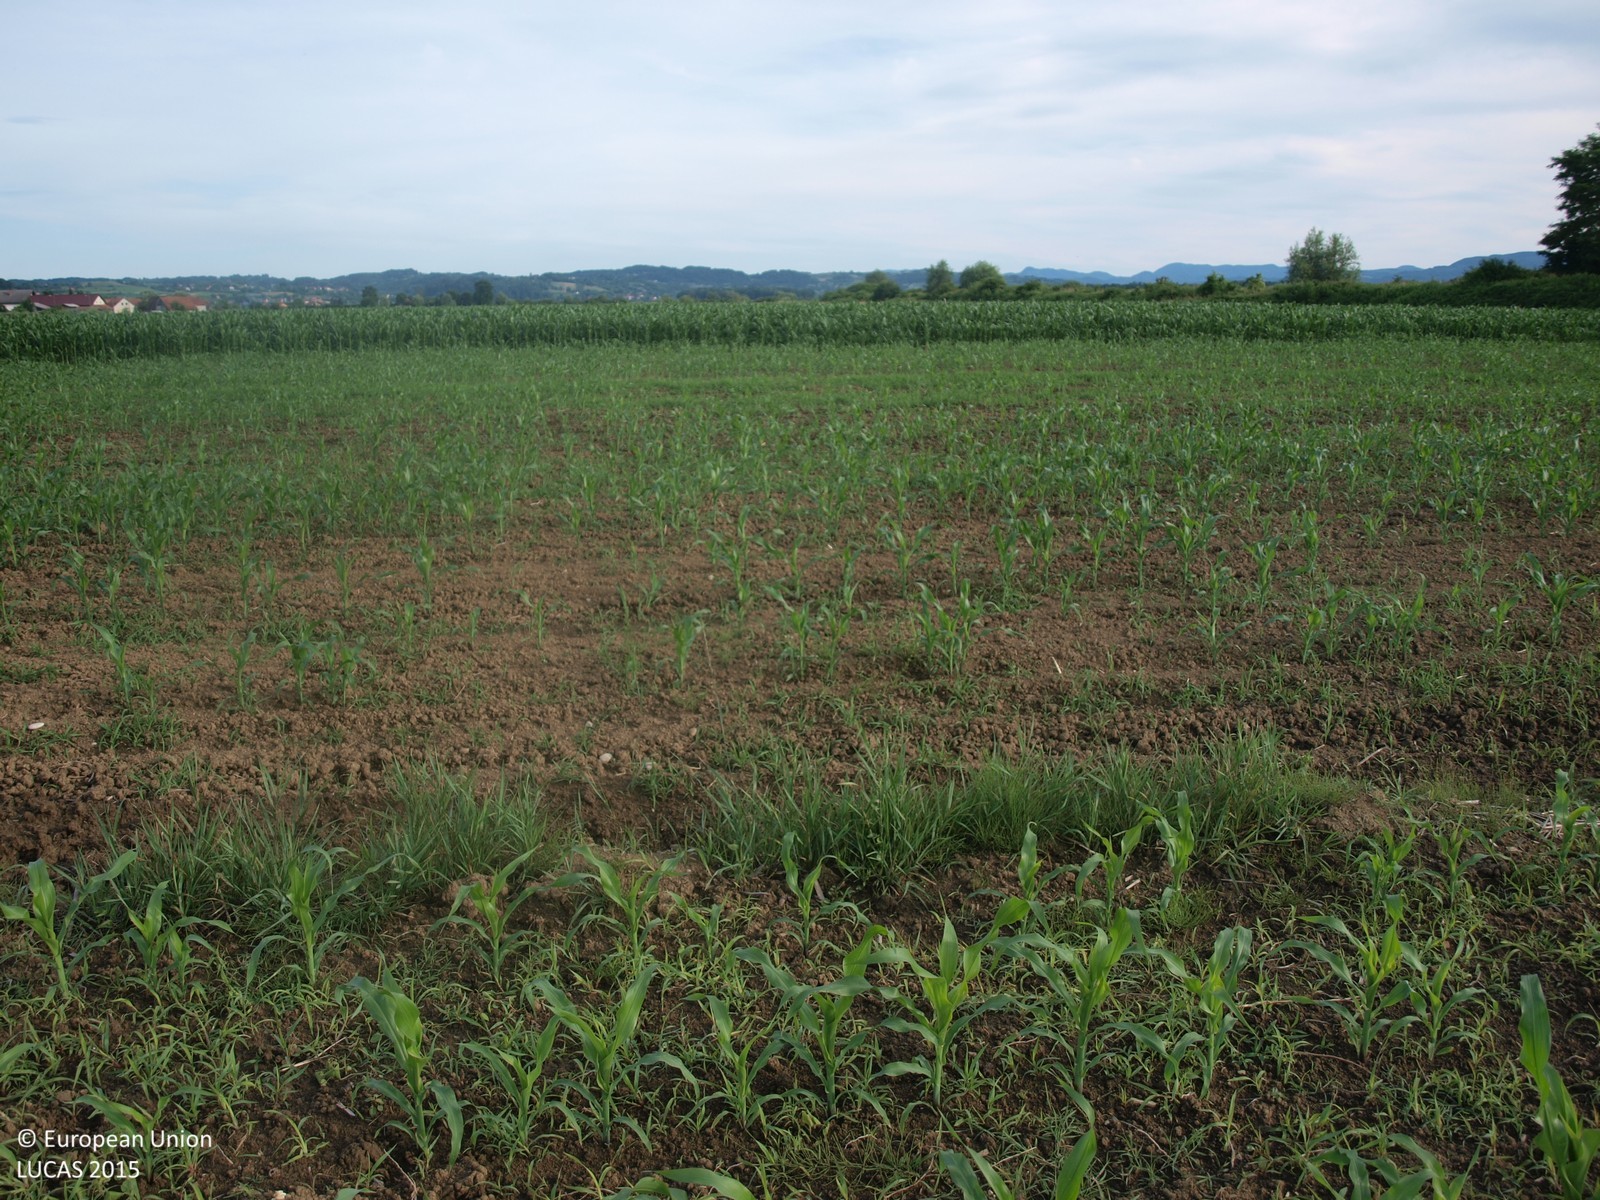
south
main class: Cropland
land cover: Maize
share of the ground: > 75 %
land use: Agriculture (excluding fallow land and kitchen gardens)
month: June
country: HR
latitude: 45.9637
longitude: 15.7142
